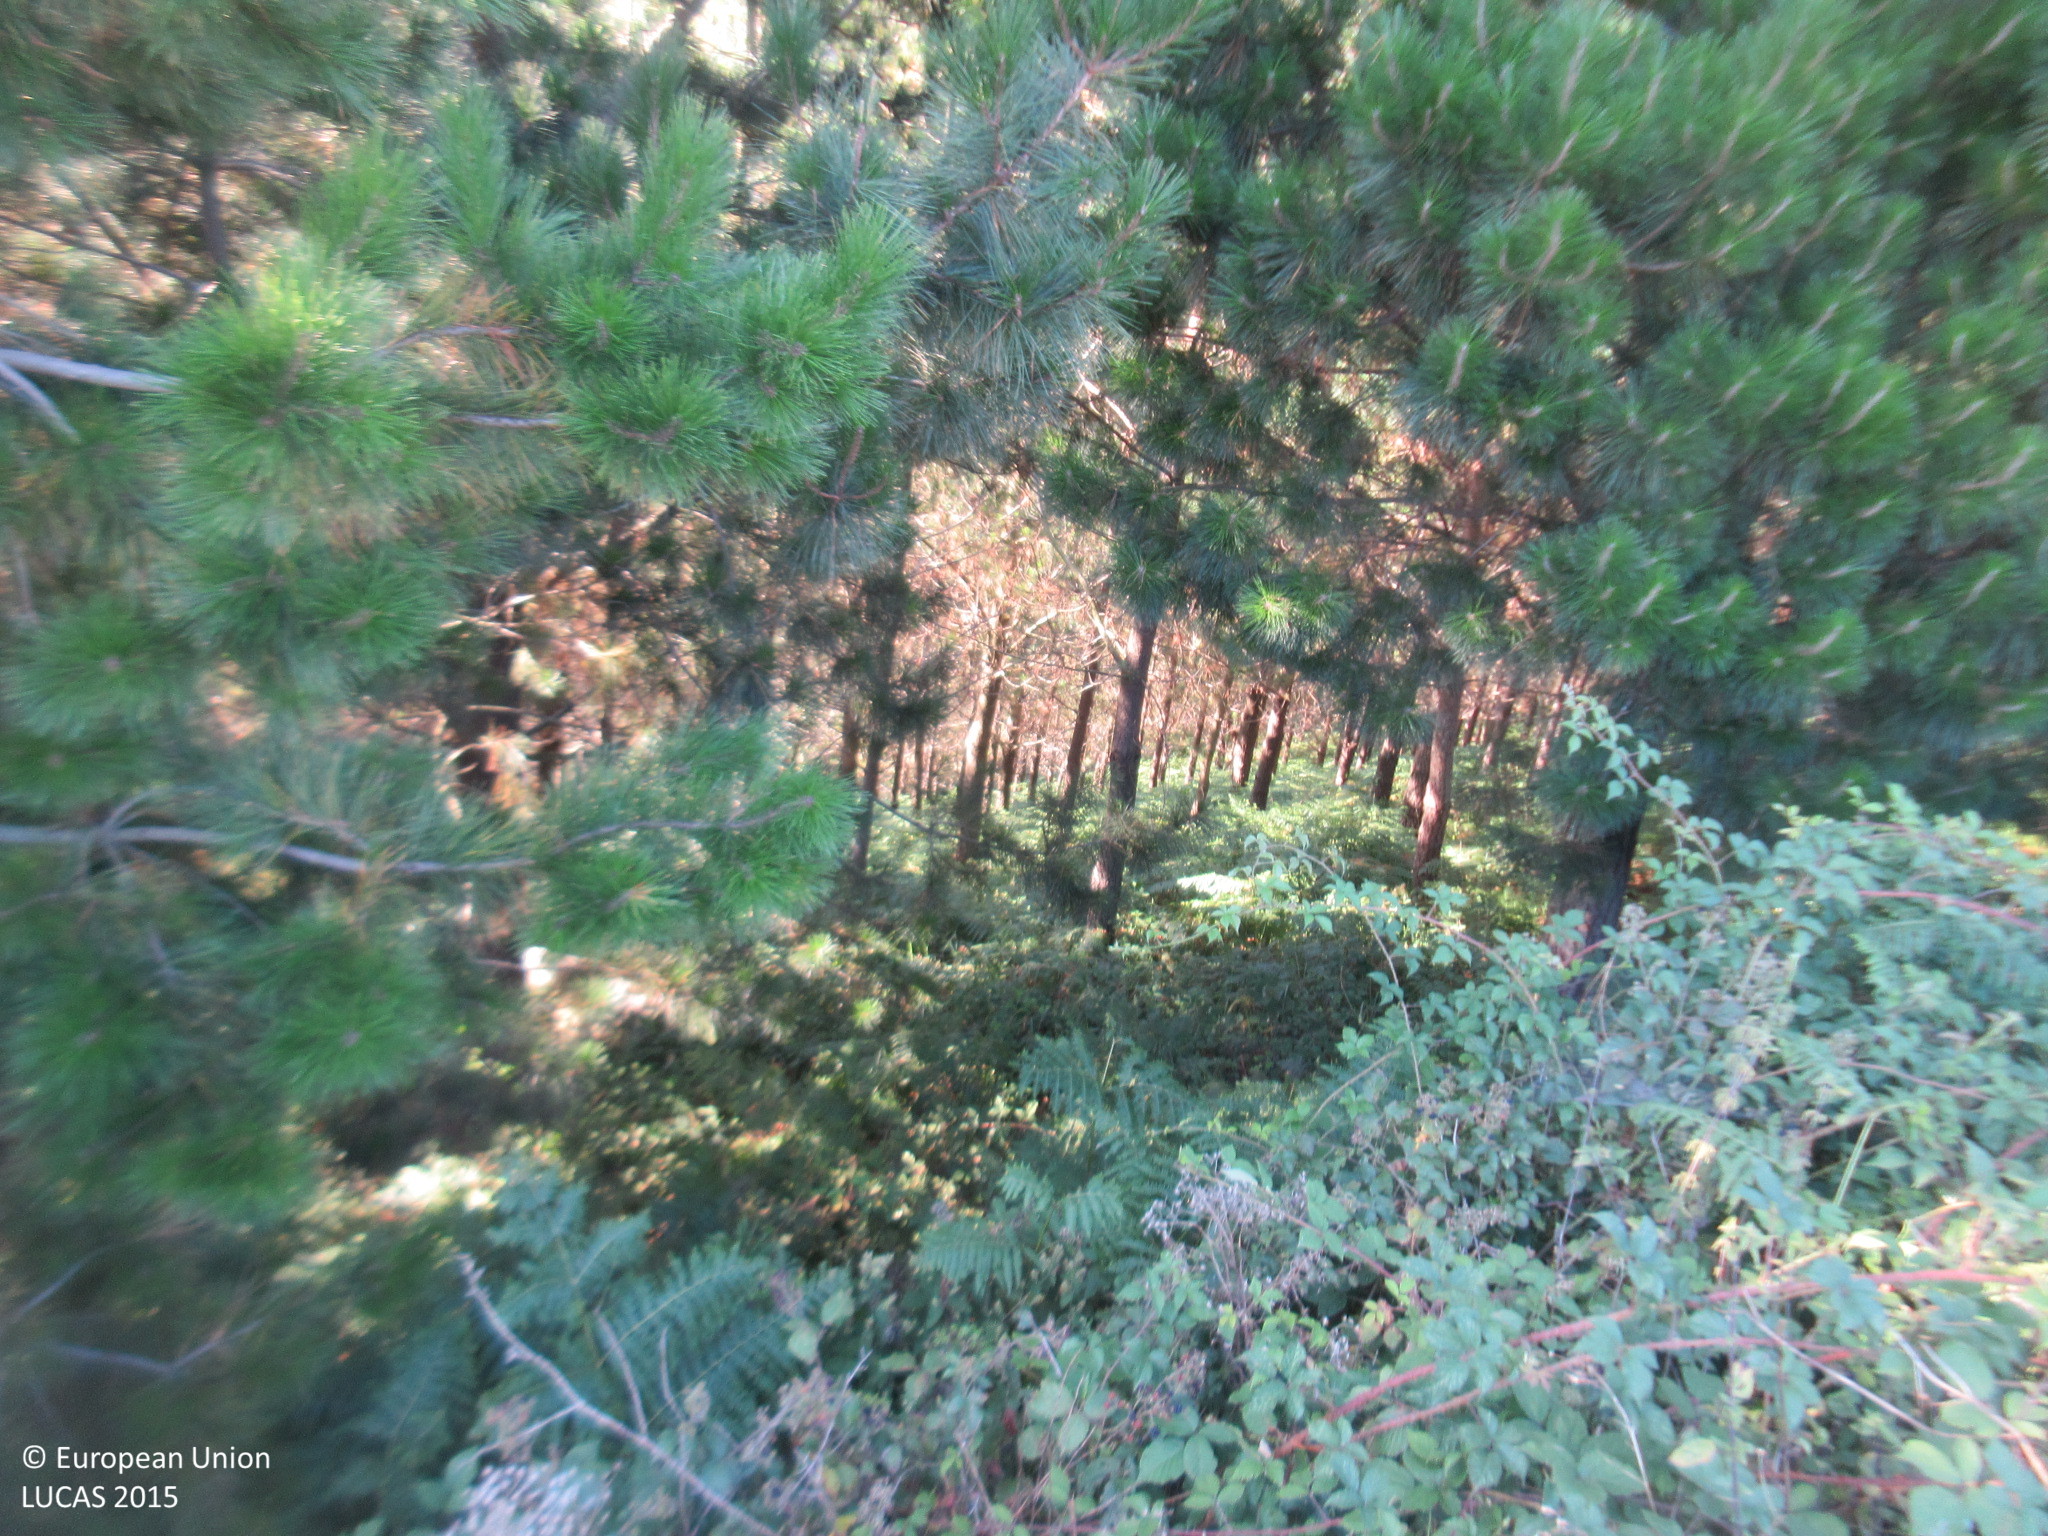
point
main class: Woodland
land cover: Pine dominated coniferous woodland
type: hemiboreal forest and nemoral coniferous forest and mixed broadleaved-coniferous forest
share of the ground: > 75 %
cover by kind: coniferous forest trees 100 %
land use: Forestry
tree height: > 5 m
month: July
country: ES
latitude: 43.1916
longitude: -3.8911
